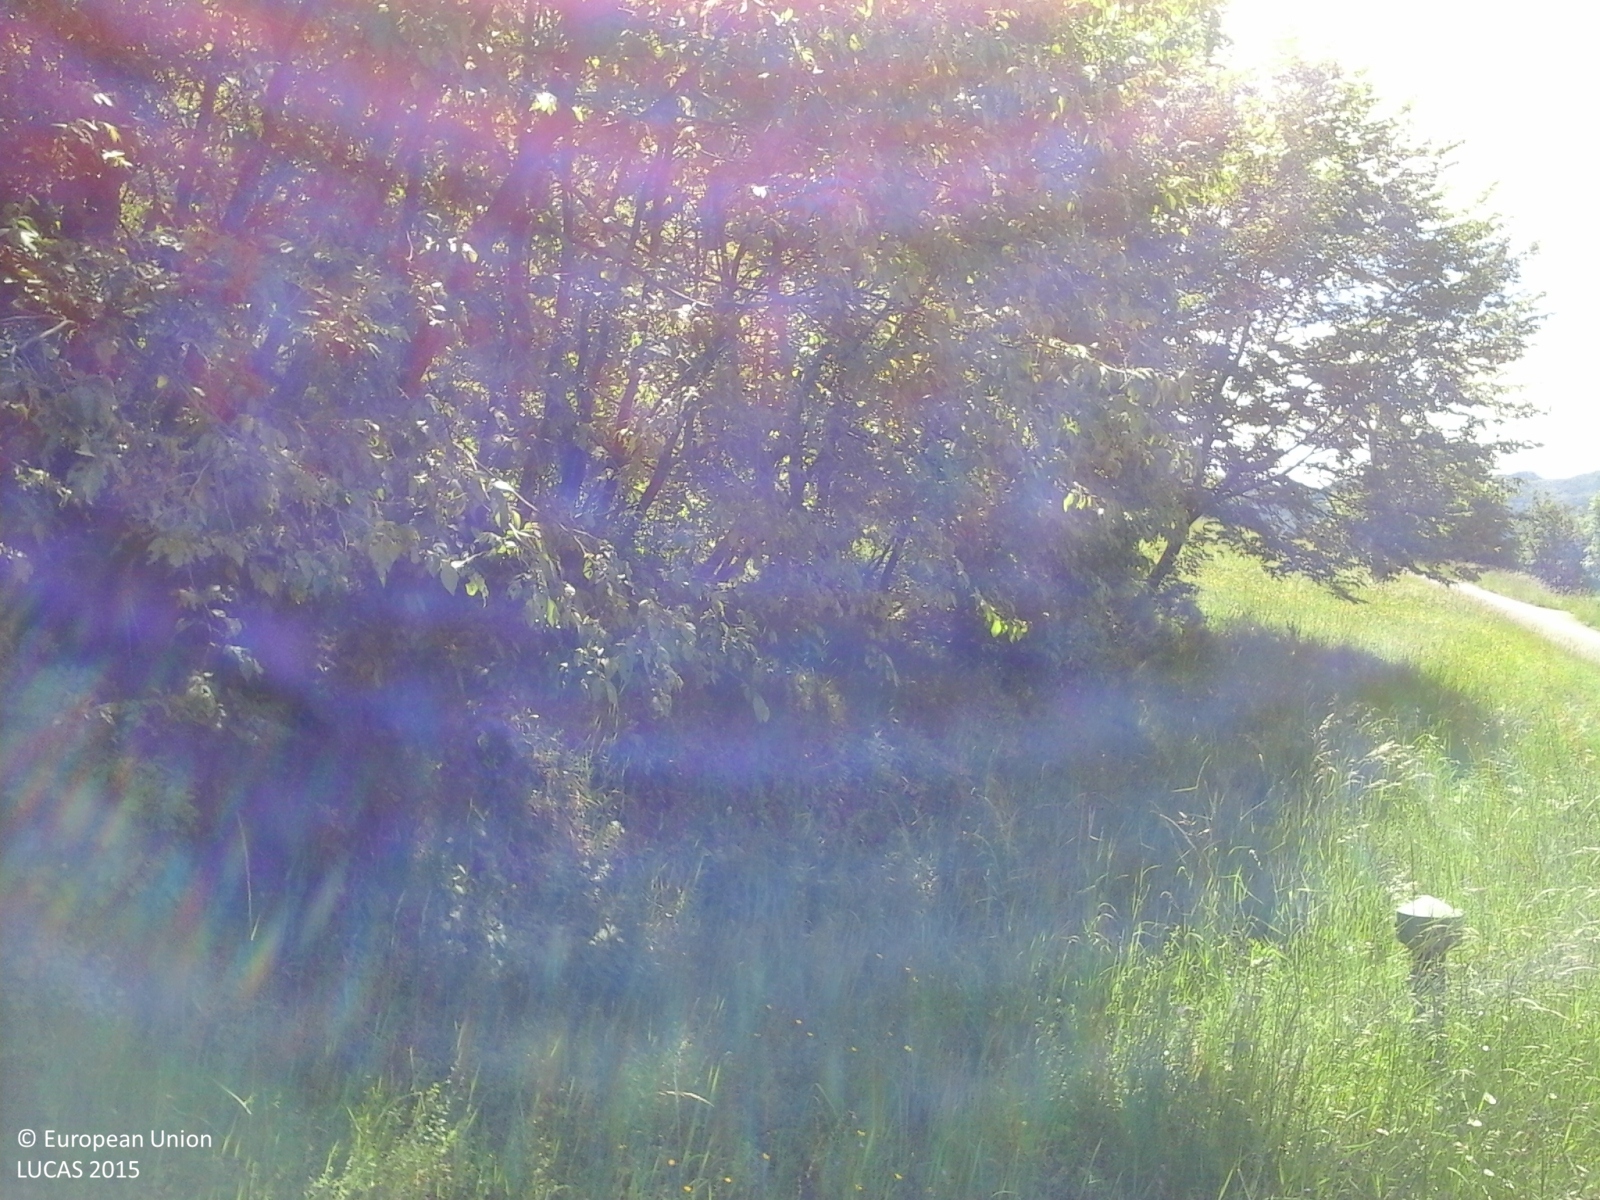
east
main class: Grassland
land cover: Grassland without tree/shrub cover
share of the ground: > 75 %
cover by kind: herbaceous plants 100 %
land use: Agriculture (excluding fallow land and kitchen gardens)
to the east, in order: Grassland without tree/shrub cover; Broadleaved woodland; Paved roads, cycling and walking lanes; Broadleaved woodland; Pine dominated mixed woodland; Grassland with sparse tree/shrub cover; Other mixed woodland; Grassland with sparse tree/shrub cover
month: May
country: IT
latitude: 45.7868
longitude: 11.1174
